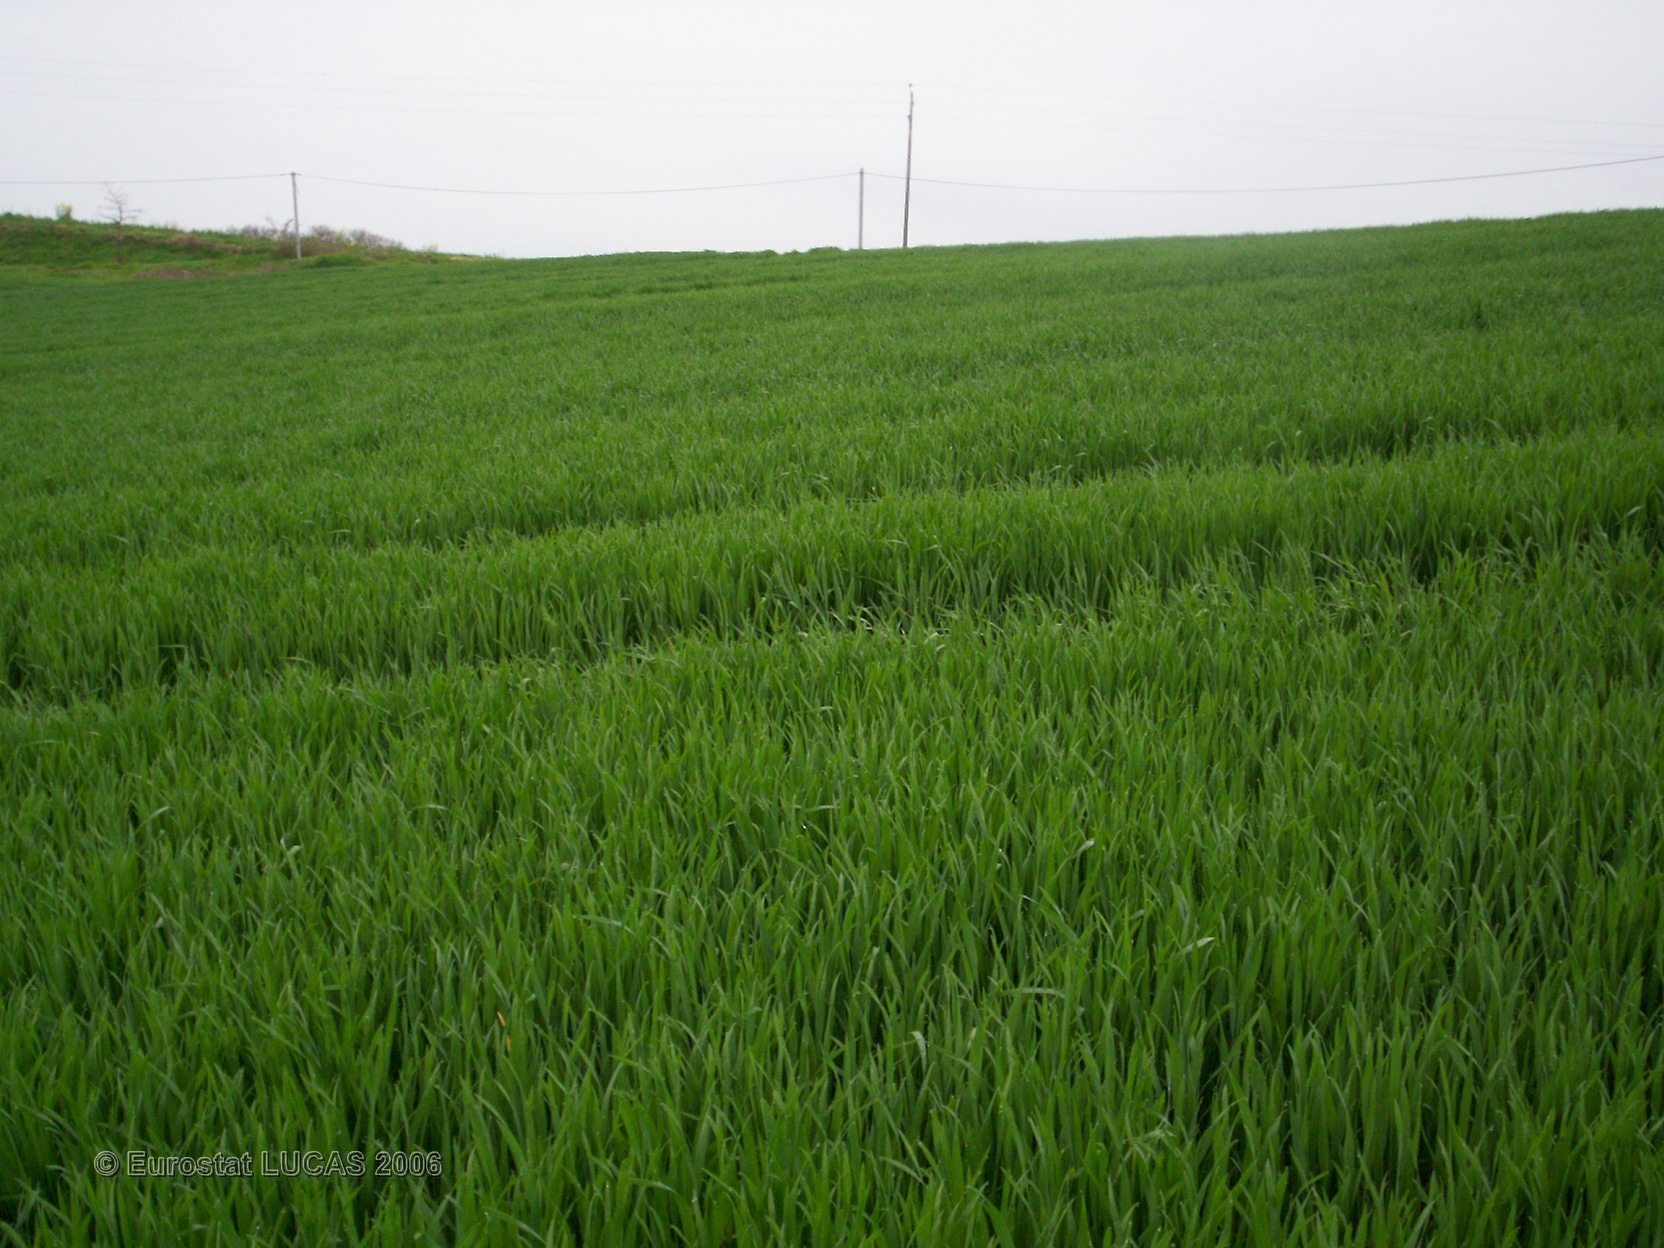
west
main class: Cropland
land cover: Common wheat
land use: Agriculture (excluding fallow land and kitchen gardens)
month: April
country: FR
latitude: 43.6042
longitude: 0.2956
